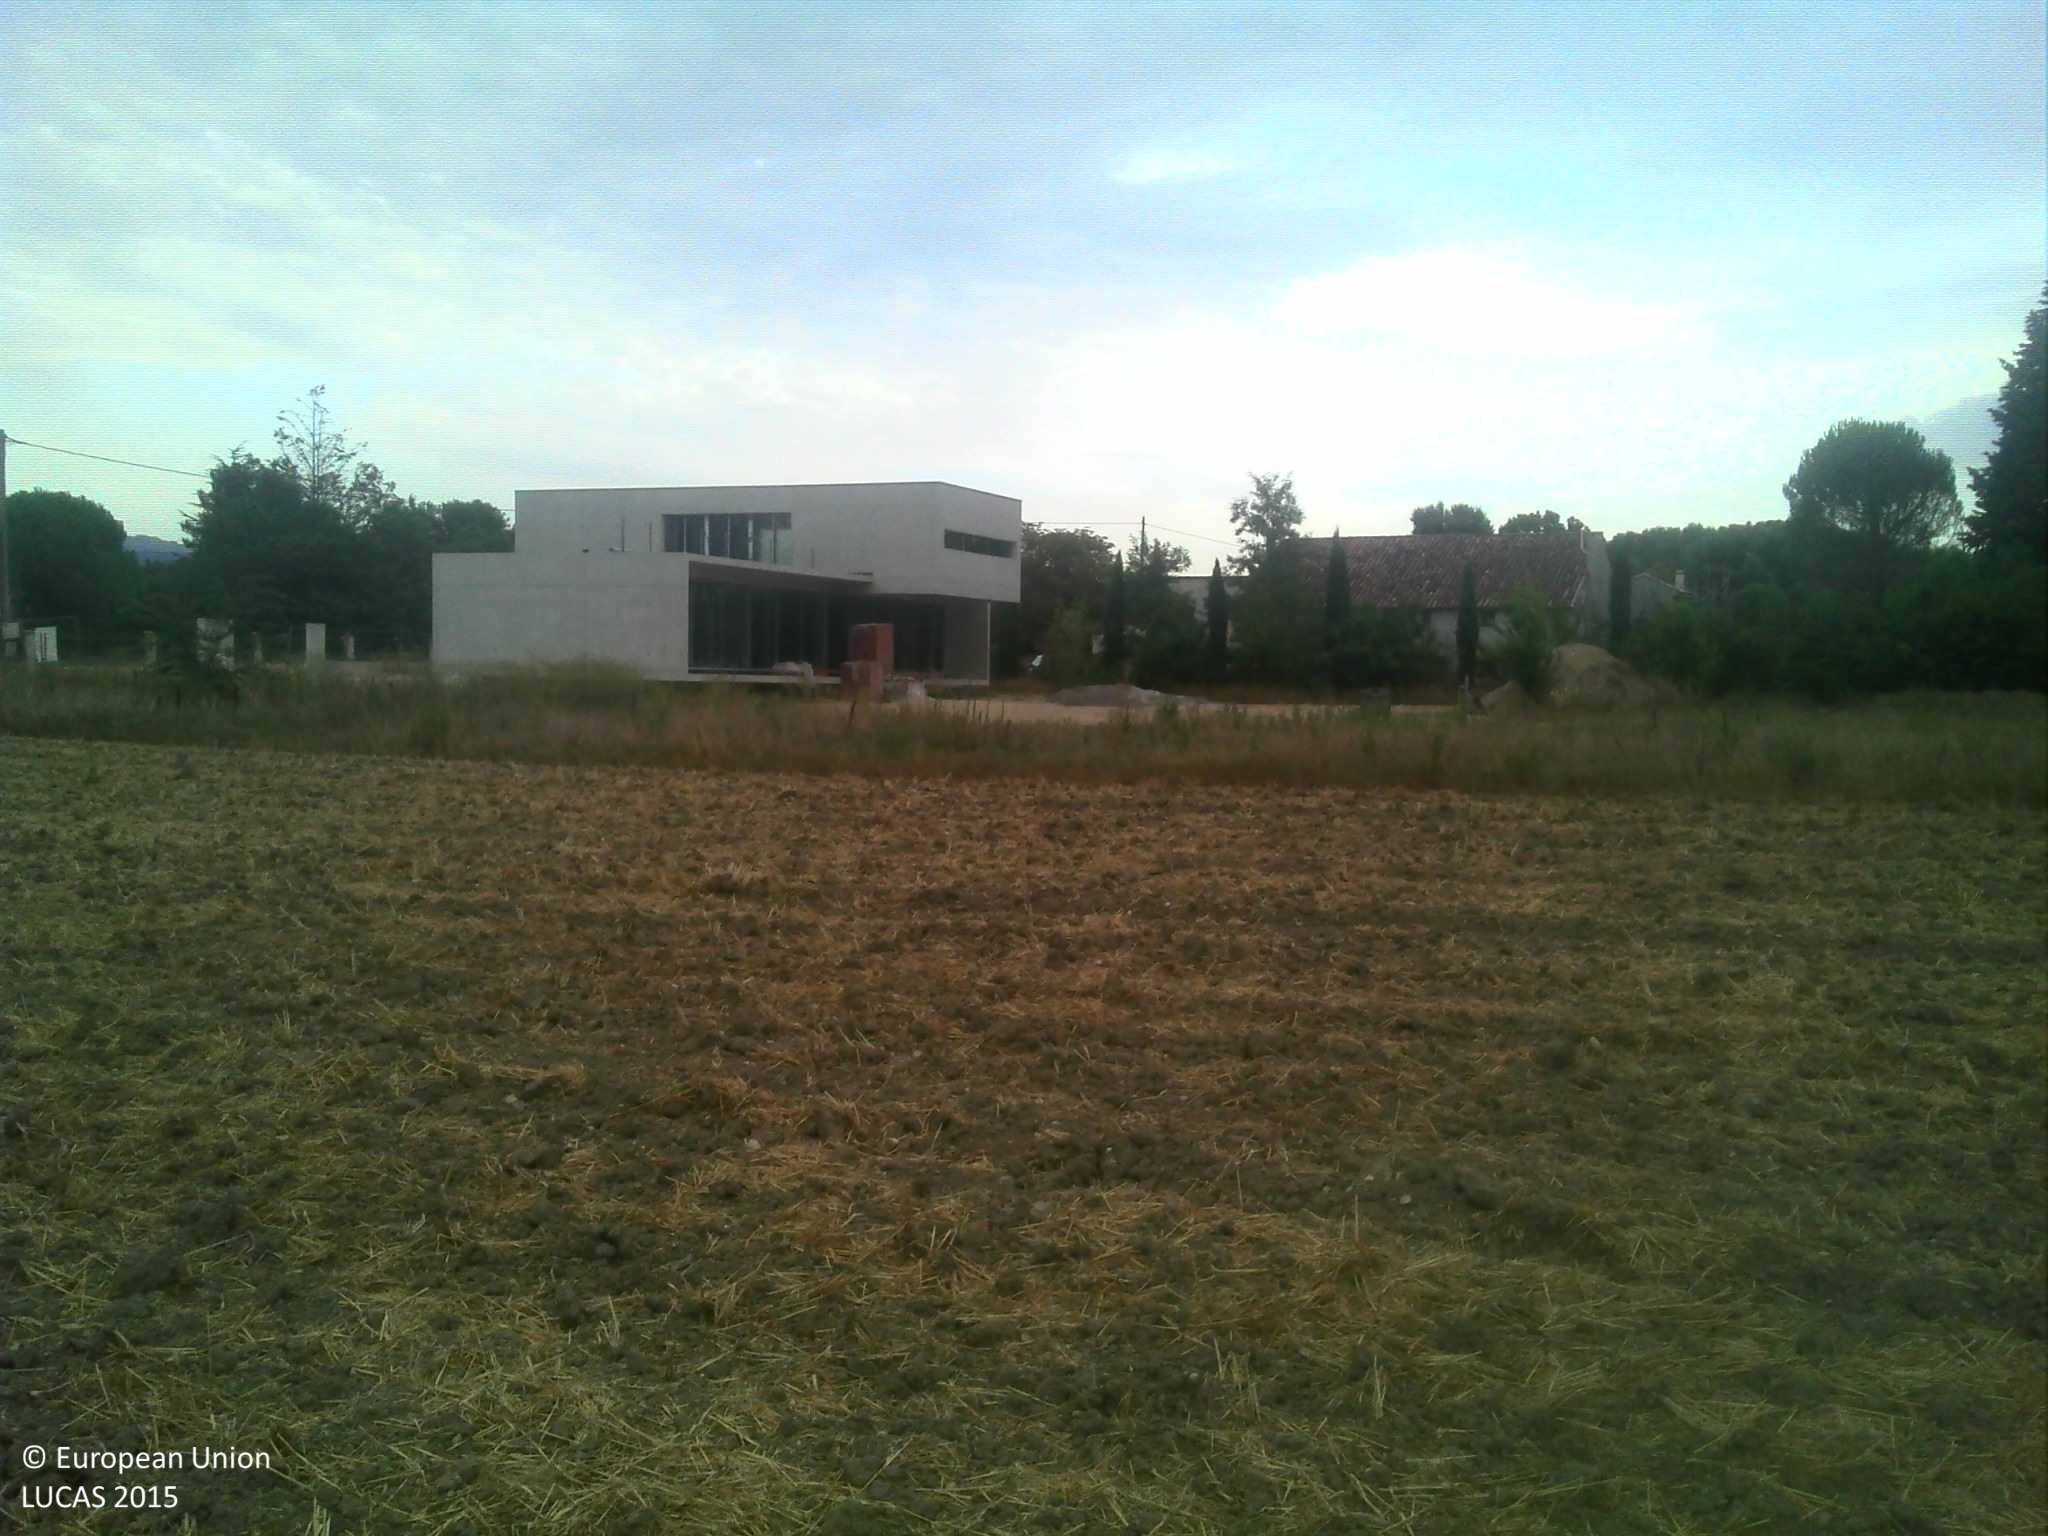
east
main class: Cropland
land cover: Durum wheat
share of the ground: 10 - 25 %
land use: Agriculture (excluding fallow land and kitchen gardens)
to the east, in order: Durum wheat; Spontaneously vegetated surfaces; Artificial constructions in urban areas; Ditches and canals; Electric lines; Grass margins; Broadleaved woodland; Artificial constructions in urban areas
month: August
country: FR
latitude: 43.4525
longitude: 5.3758
